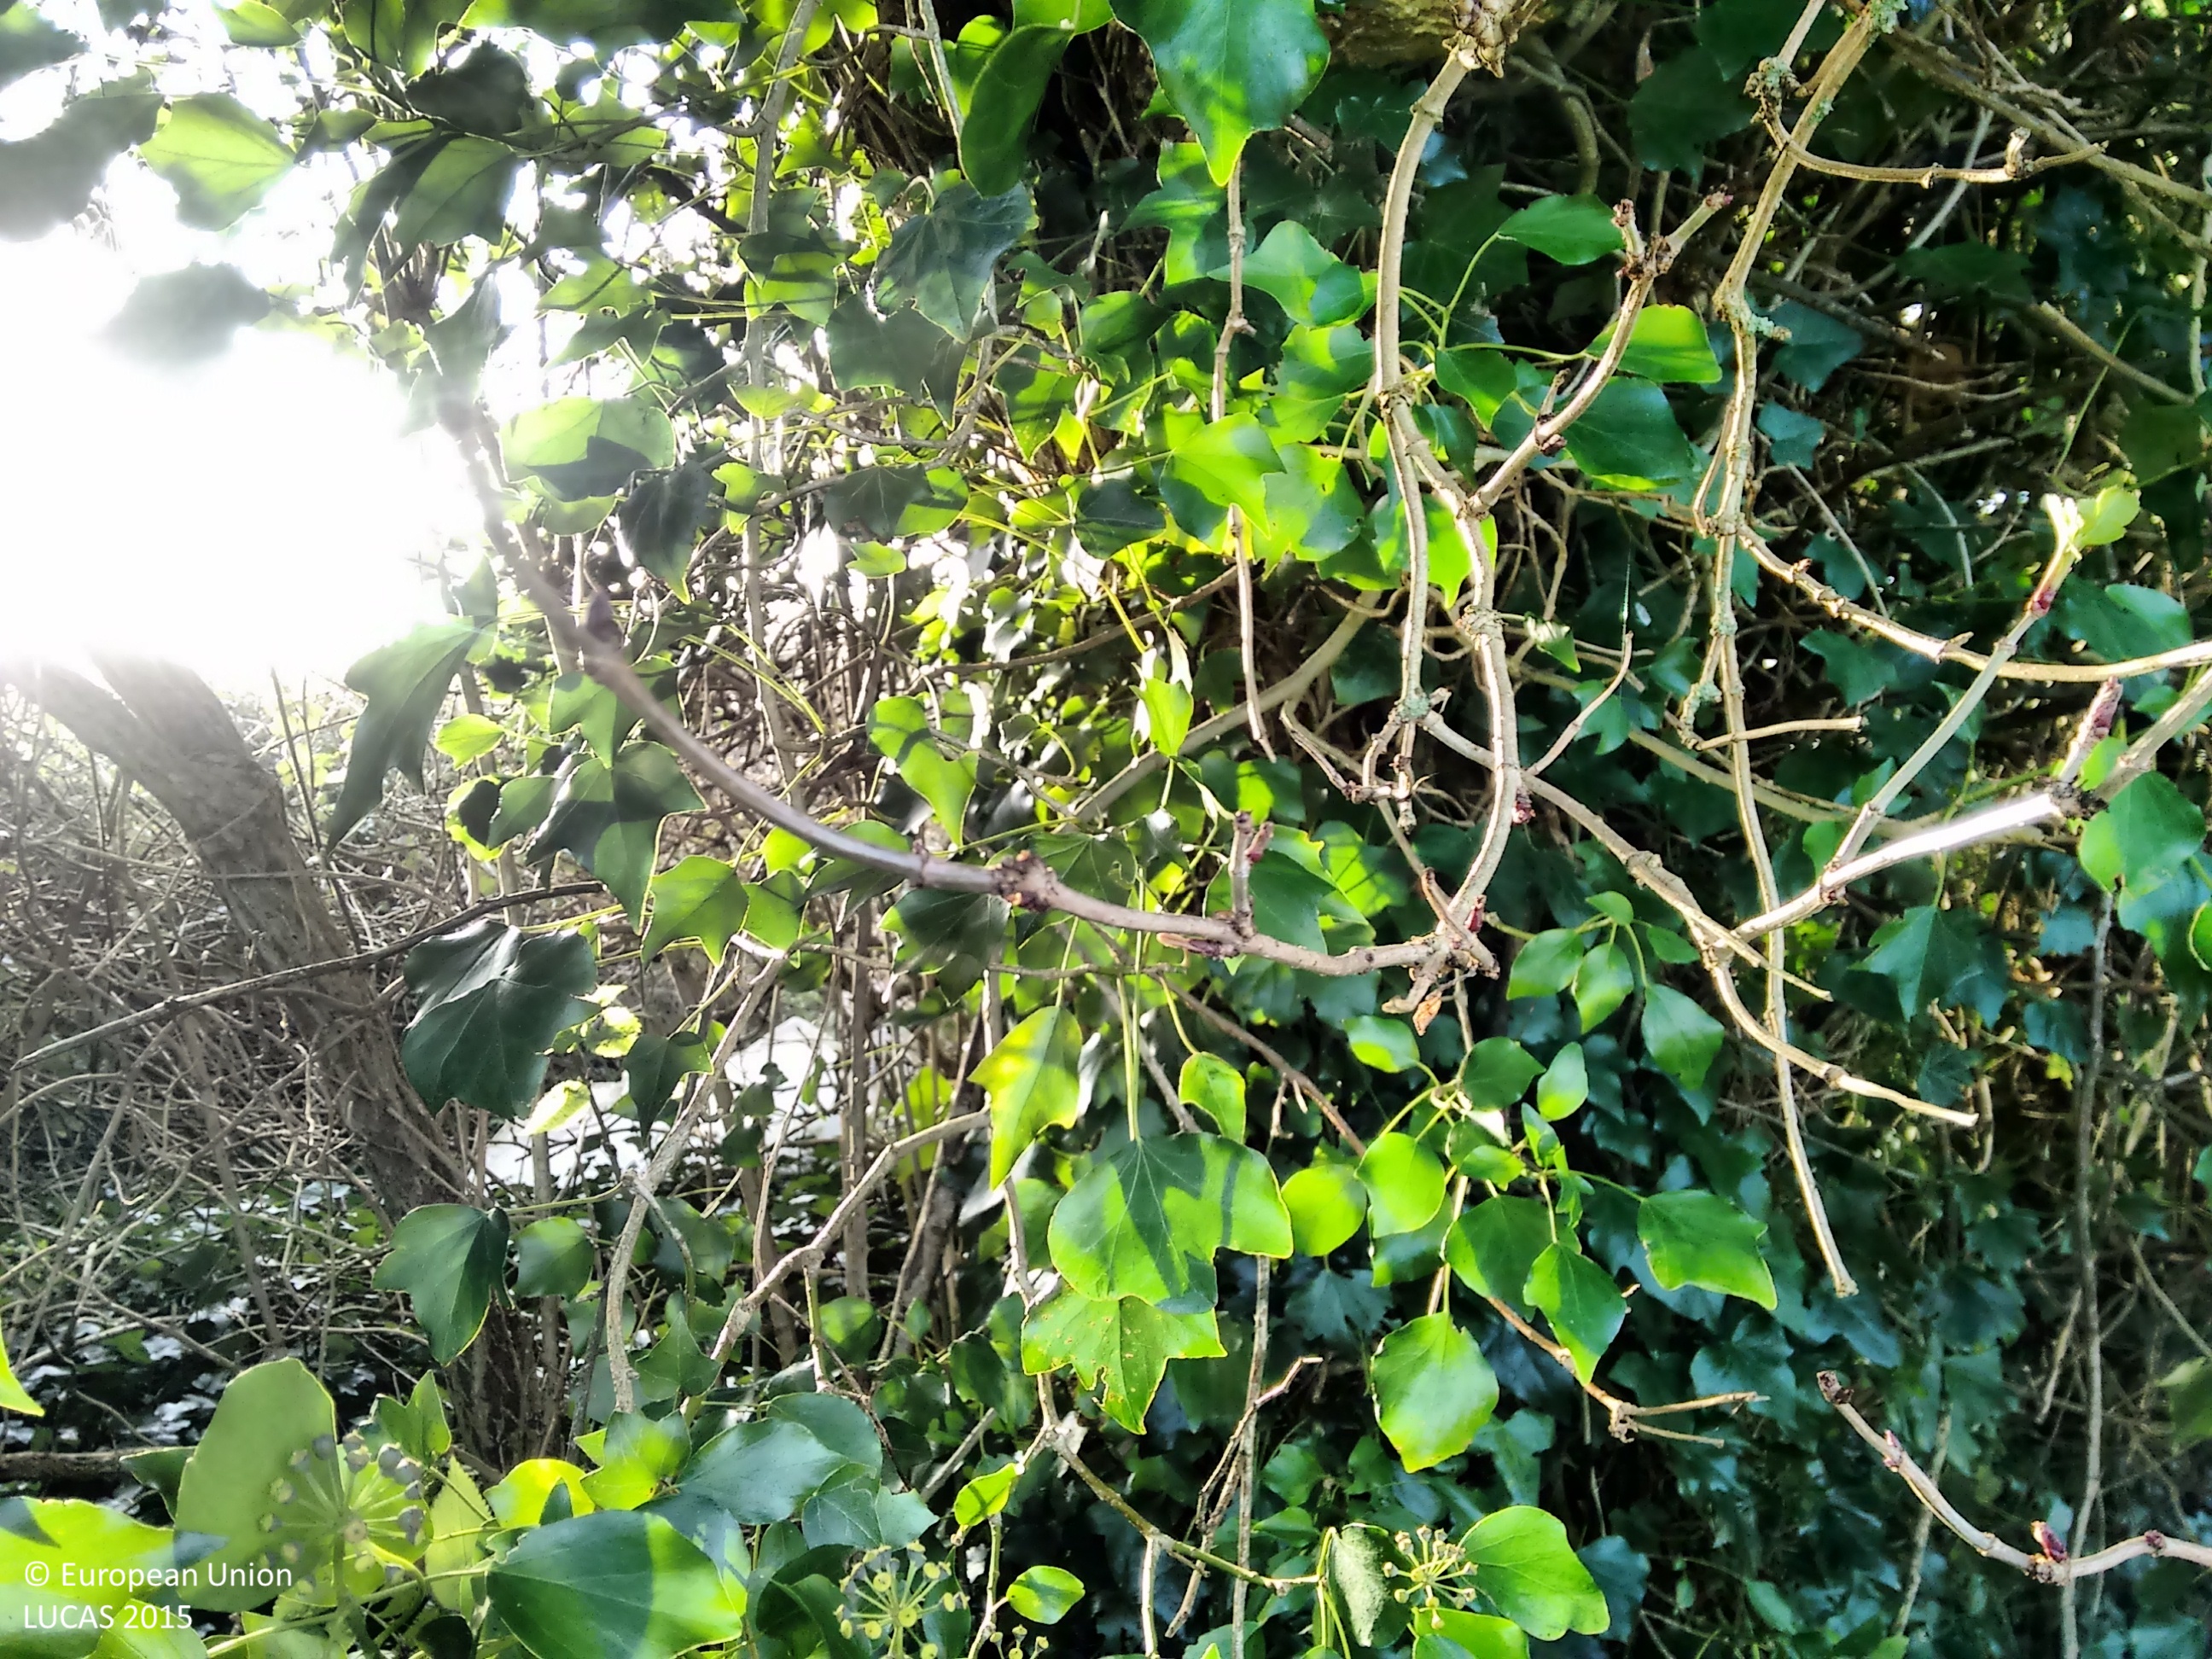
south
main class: Grassland
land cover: Spontaneously vegetated surfaces
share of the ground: > 75 %
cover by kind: herbaceous plants 95 %, shrubs 5 %
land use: Abandoned areas
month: December
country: IE
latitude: 53.7262
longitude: -6.3855
